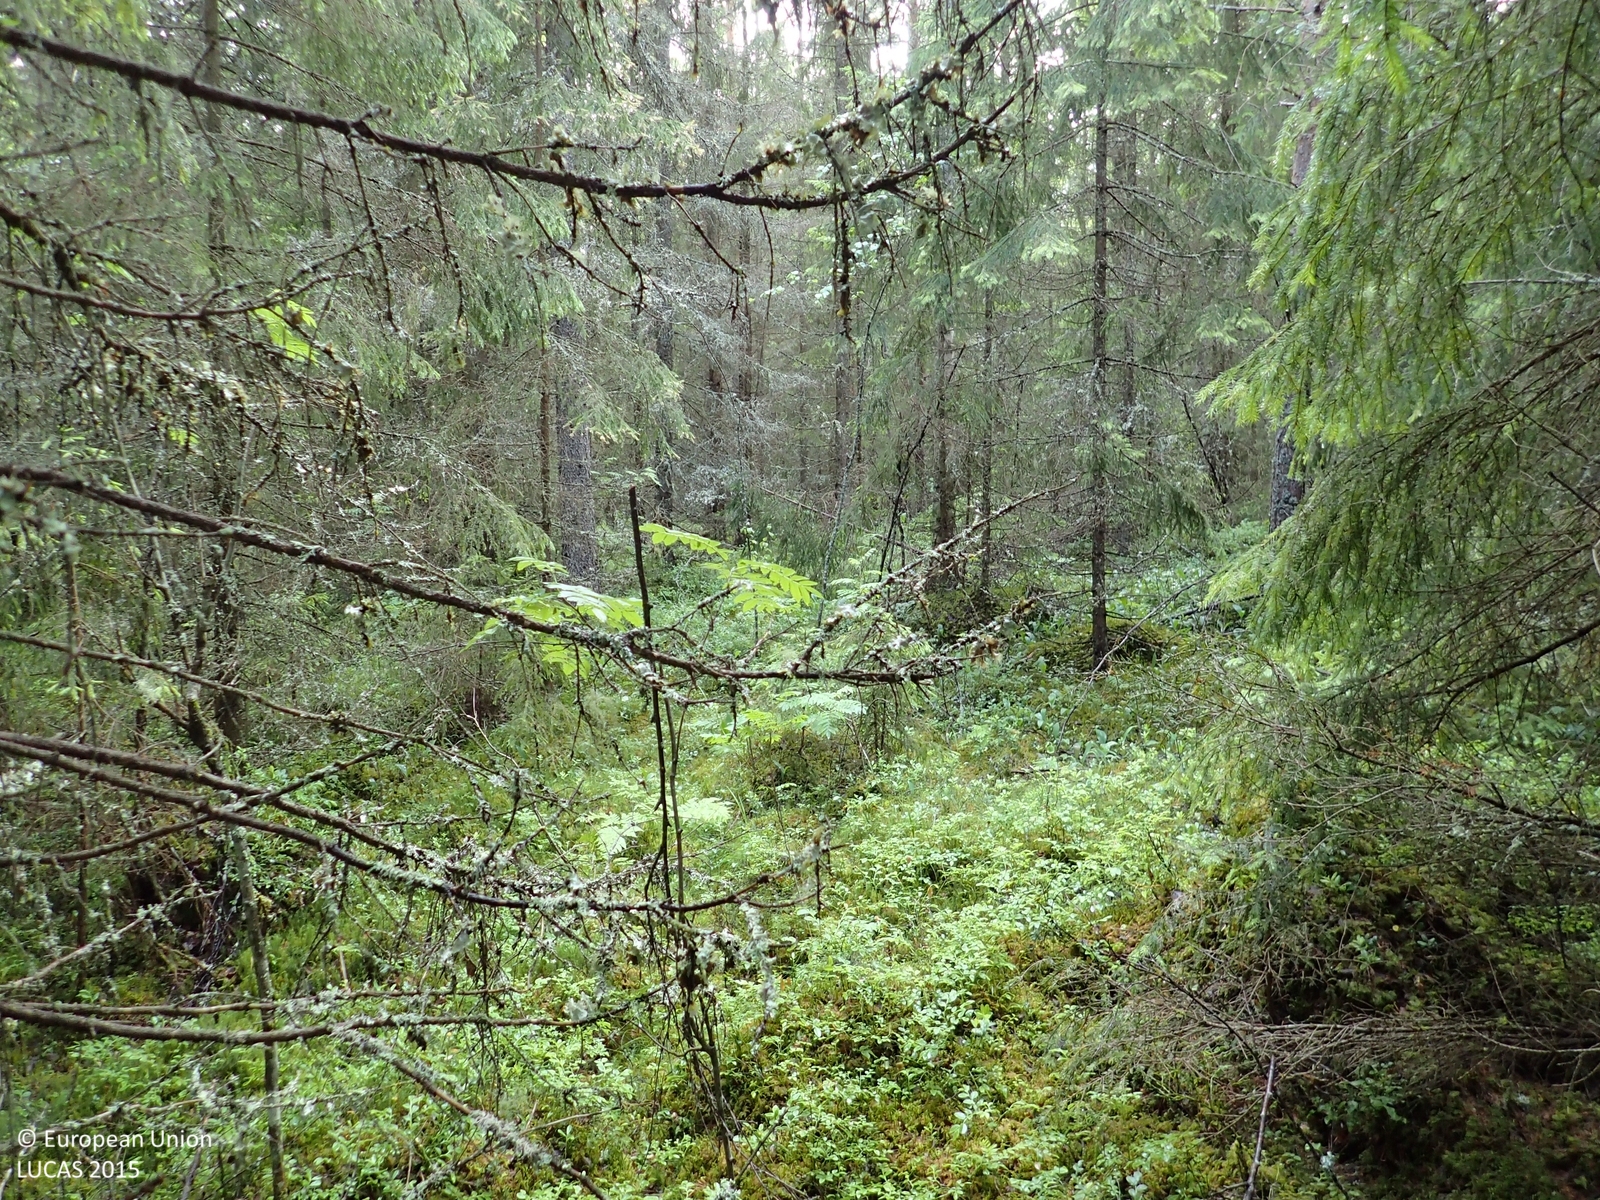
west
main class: Woodland
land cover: Spruce dominated coniferous woodland
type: boreal forest
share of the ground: > 75 %
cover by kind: coniferous forest trees 75 %, broadleaved forest trees 10 %, shrubs 10 %, lichens and mosses 5 %
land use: Forestry
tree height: > 5 m
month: July
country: FI
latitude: 62.8791
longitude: 21.5434
